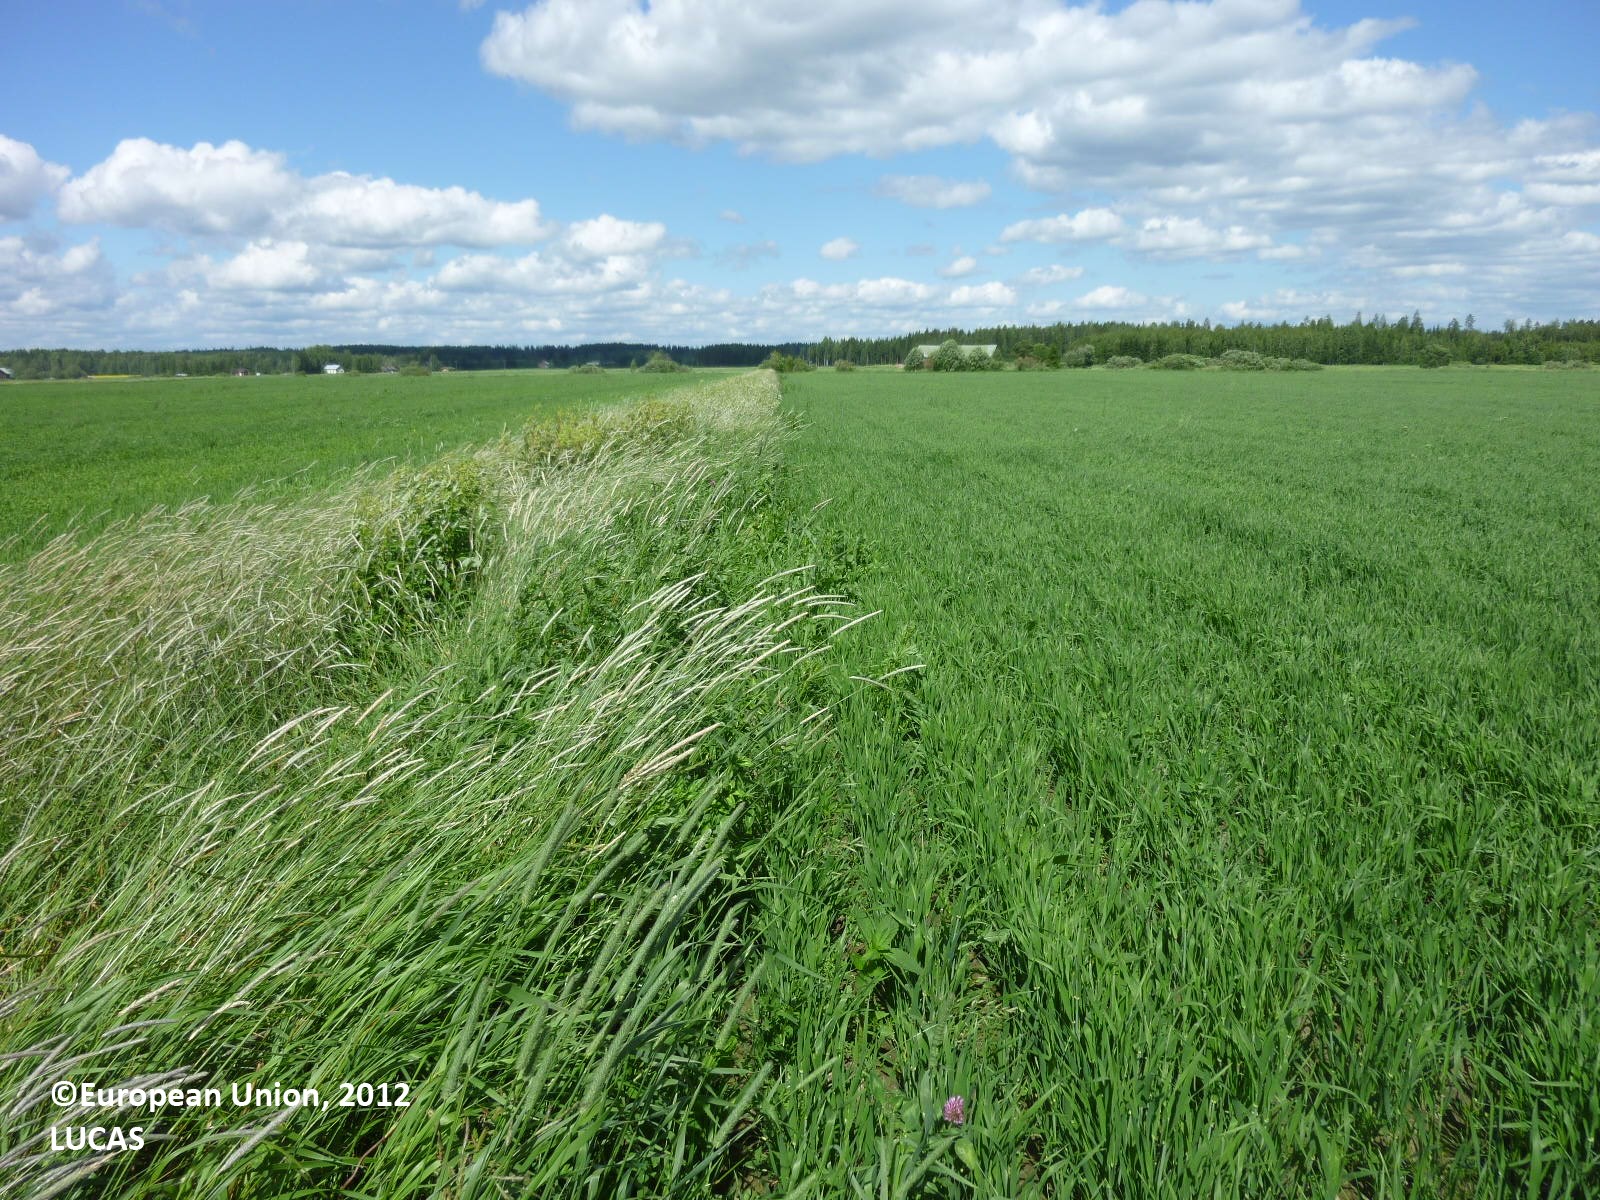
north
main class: Cropland
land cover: Barley
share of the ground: > 75 %
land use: Agriculture (excluding fallow land and kitchen gardens)
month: July
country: FI
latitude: 61.1840
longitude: 22.8103
